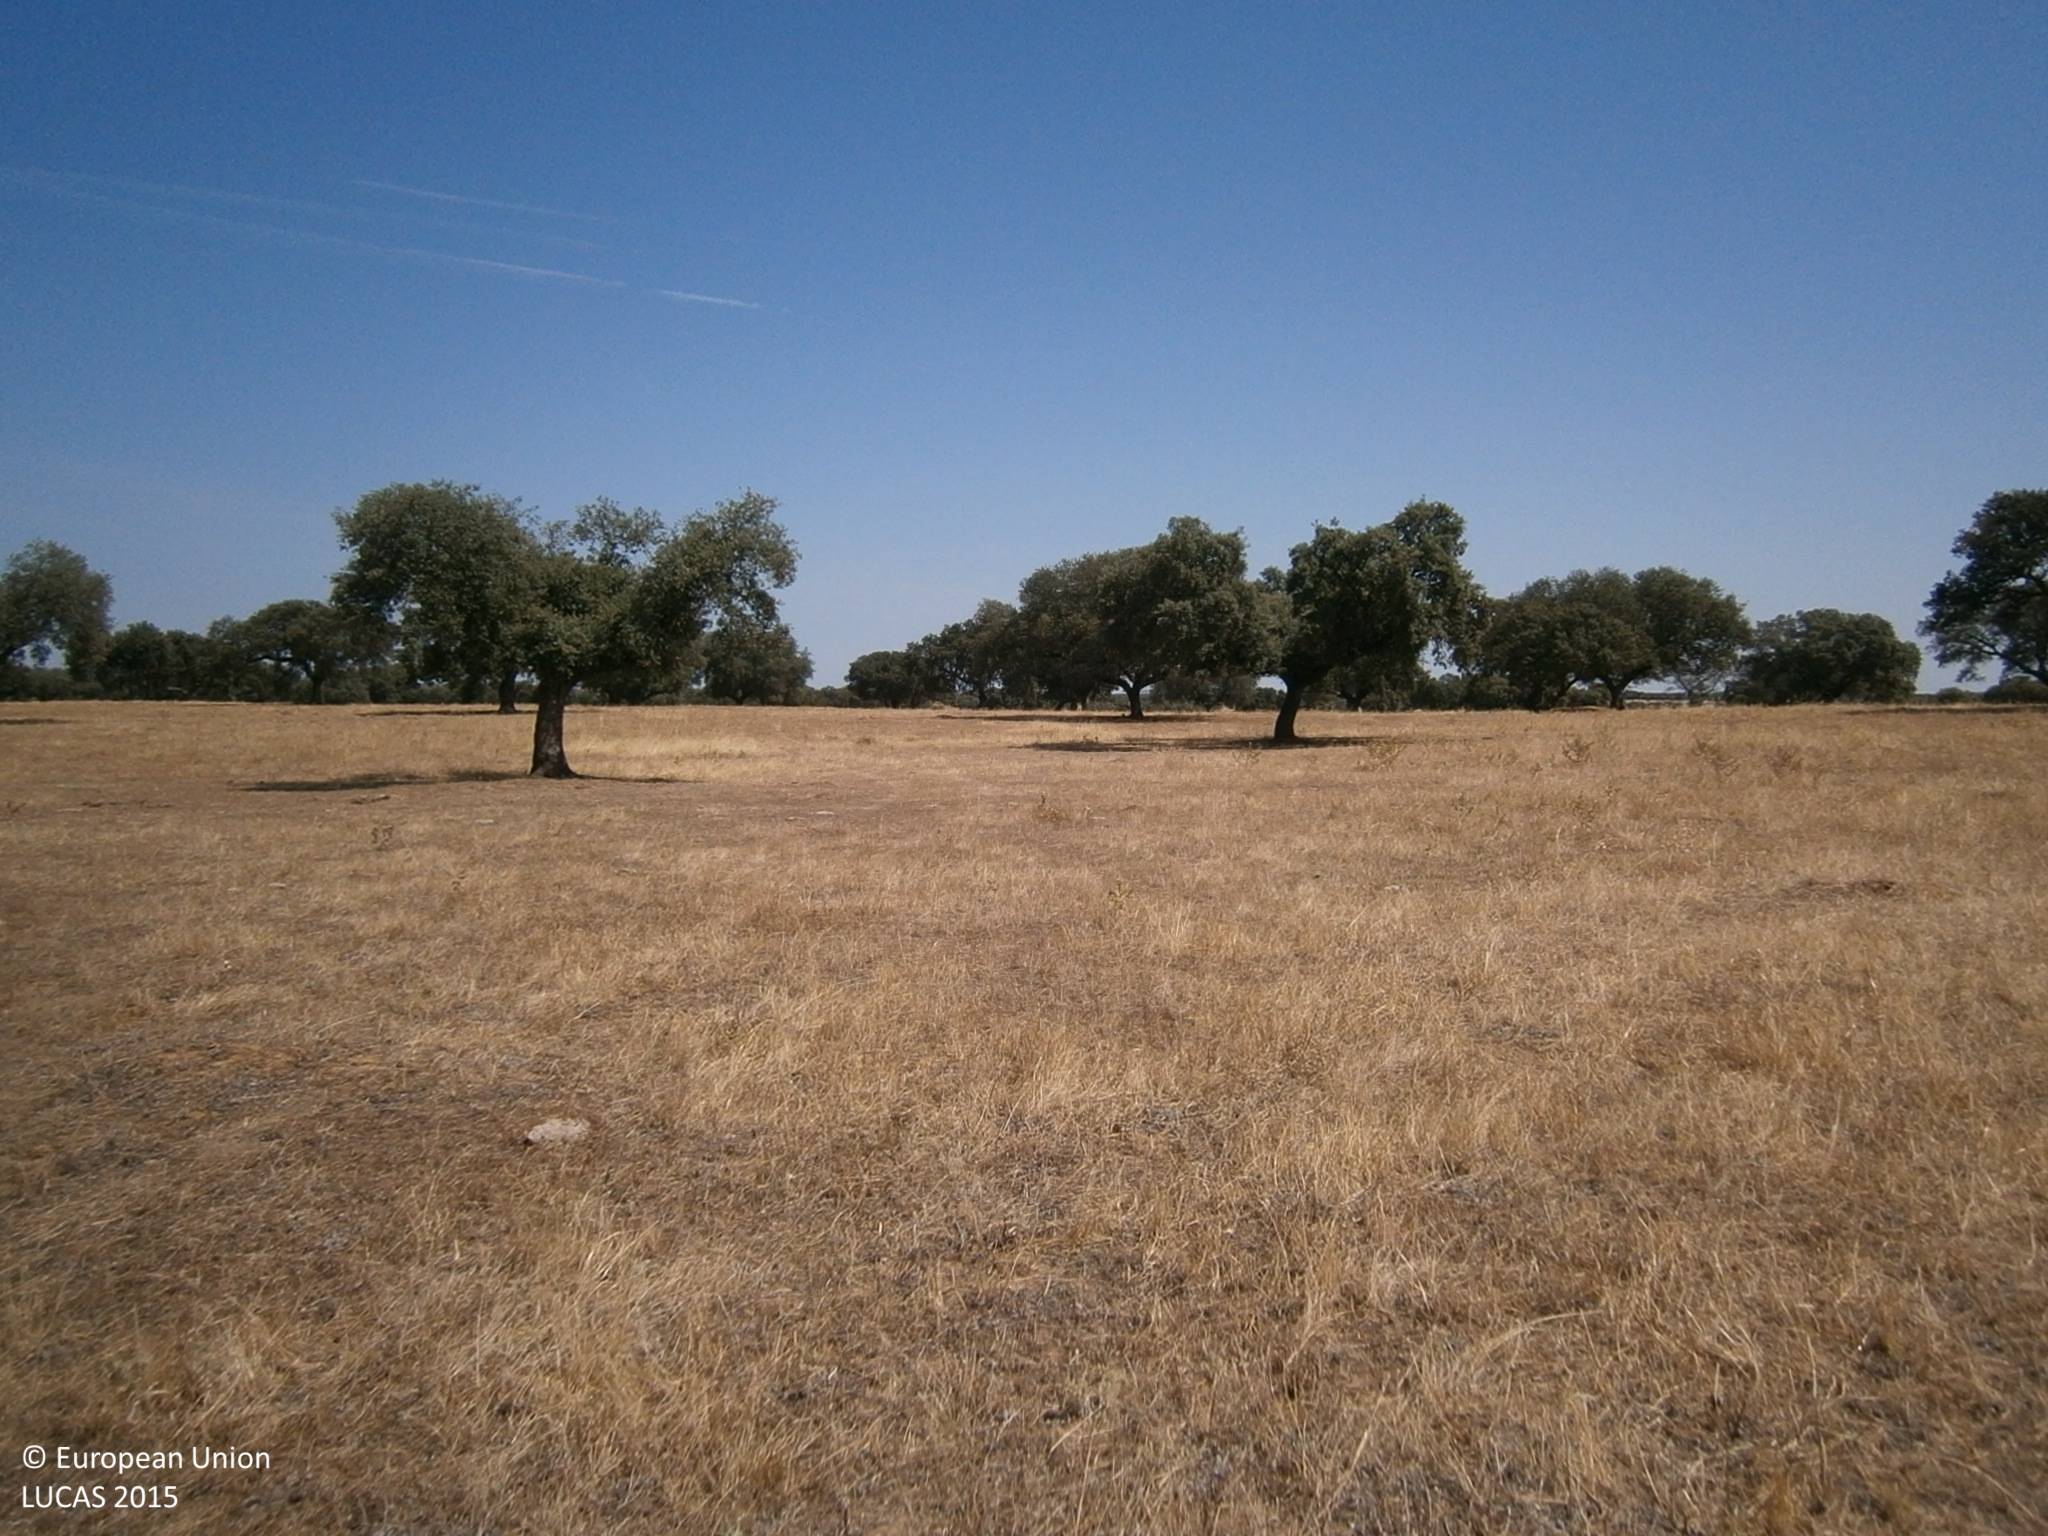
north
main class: Woodland
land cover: Broadleaved woodland
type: broadleaved evergreen forest
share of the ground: > 75 %
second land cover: Spontaneously vegetated surfaces
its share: > 75 %
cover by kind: broadleaved forest trees 90 %, unconsolidated bare surface 5 %
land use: Forestry
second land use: Agriculture (excluding fallow land and kitchen gardens)
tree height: > 5 m
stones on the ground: < 10 %
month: July
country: ES
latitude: 39.0014
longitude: -6.8471
